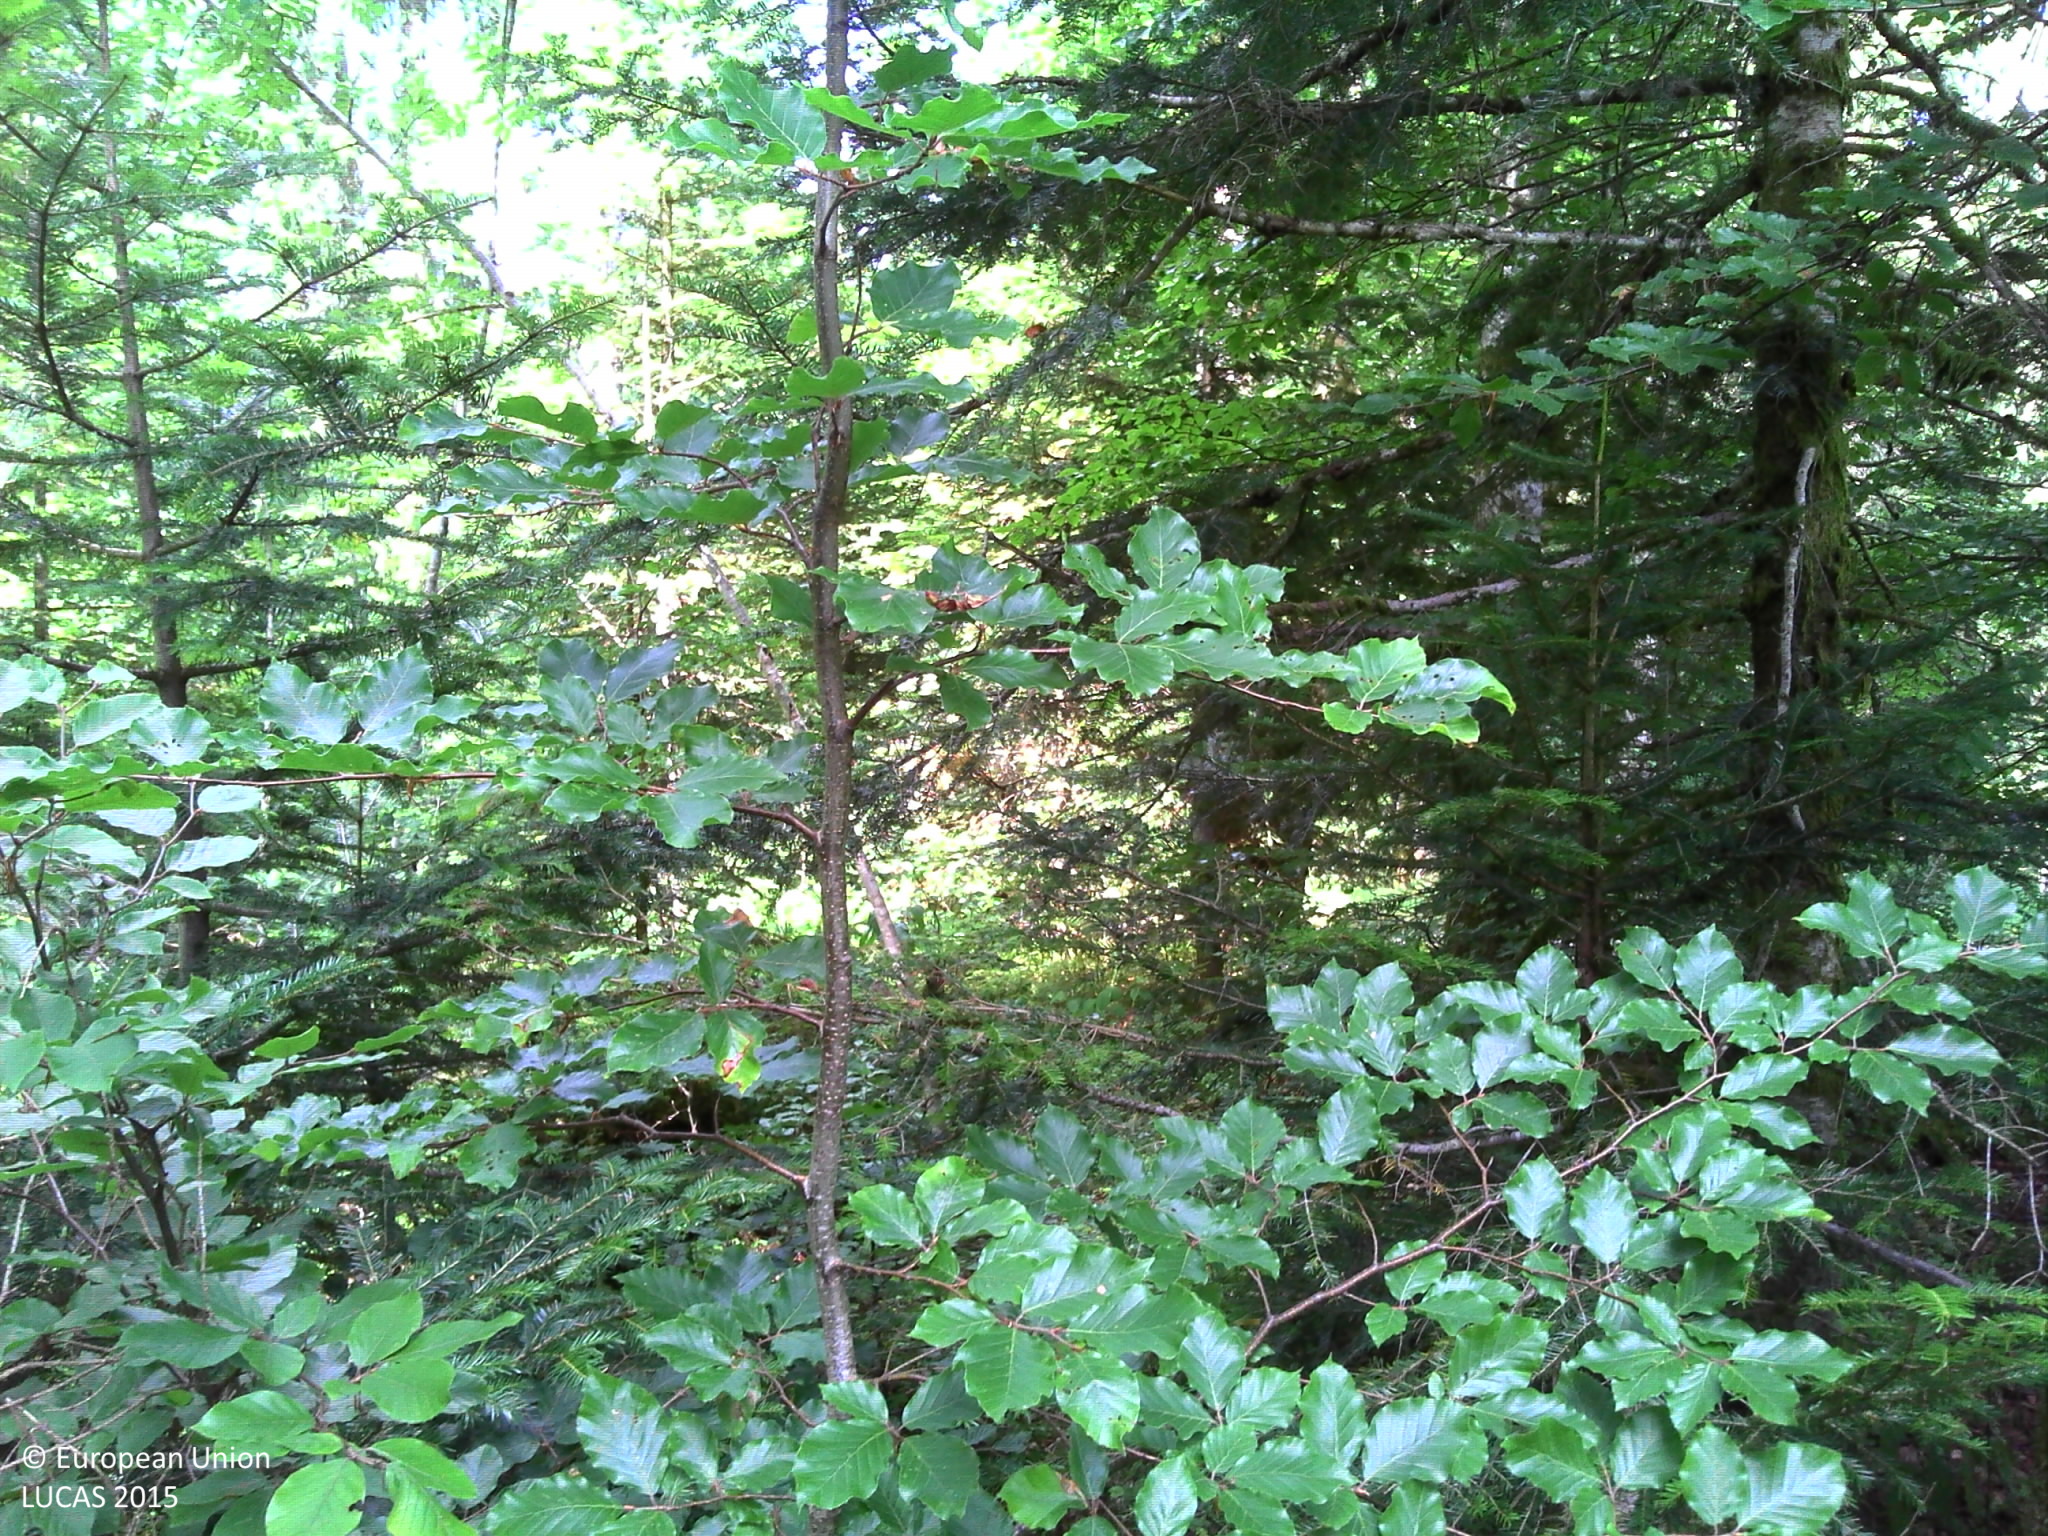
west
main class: Woodland
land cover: Other mixed woodland
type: mountainous beech forest
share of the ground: > 75 %
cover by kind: coniferous forest trees 30 %, broadleaved forest trees 30 %, lichens and mosses 15 %, consolidated bare surface 15 %, herbaceous plants 10 %
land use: Forestry
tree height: > 5 m
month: July
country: FR
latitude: 46.7513
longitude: 6.1670
